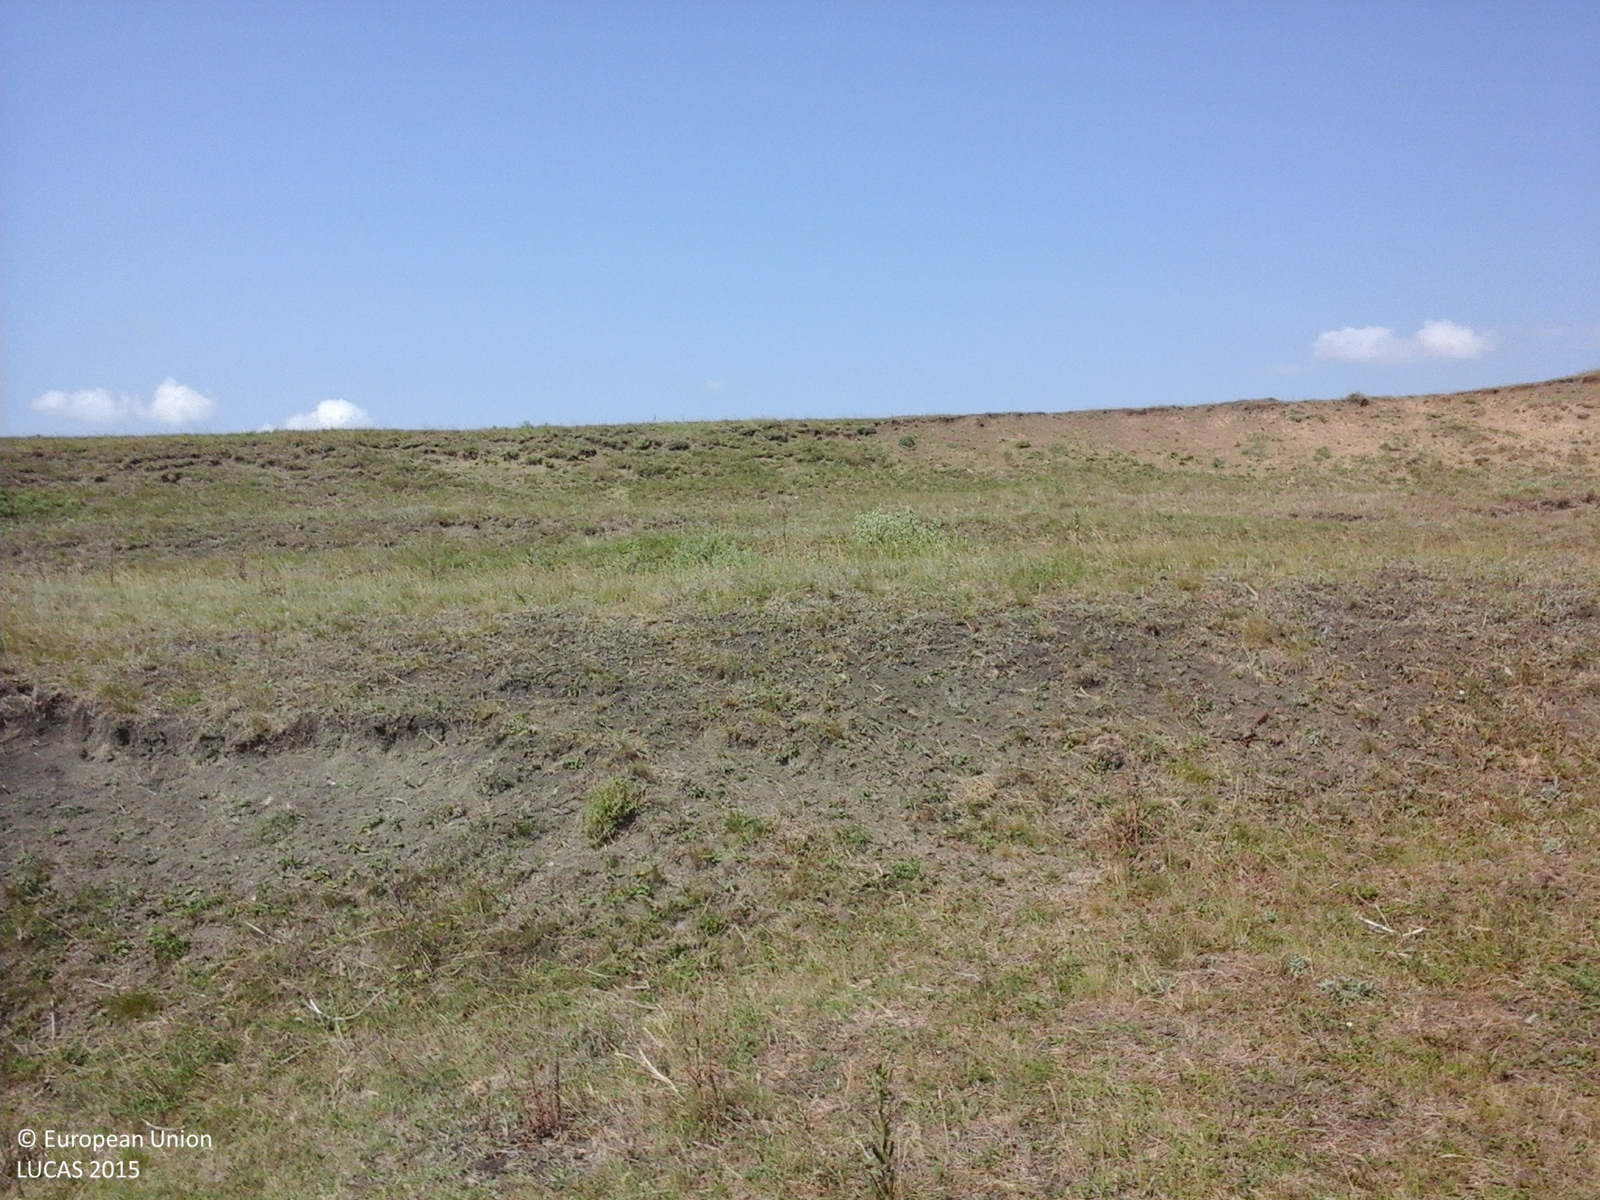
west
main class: Grassland
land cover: Grassland without tree/shrub cover
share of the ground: > 75 %
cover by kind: herbaceous plants 90 %, unconsolidated bare surface 10 %
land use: Agriculture (excluding fallow land and kitchen gardens)
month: June
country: RO
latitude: 47.9461
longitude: 26.7131
